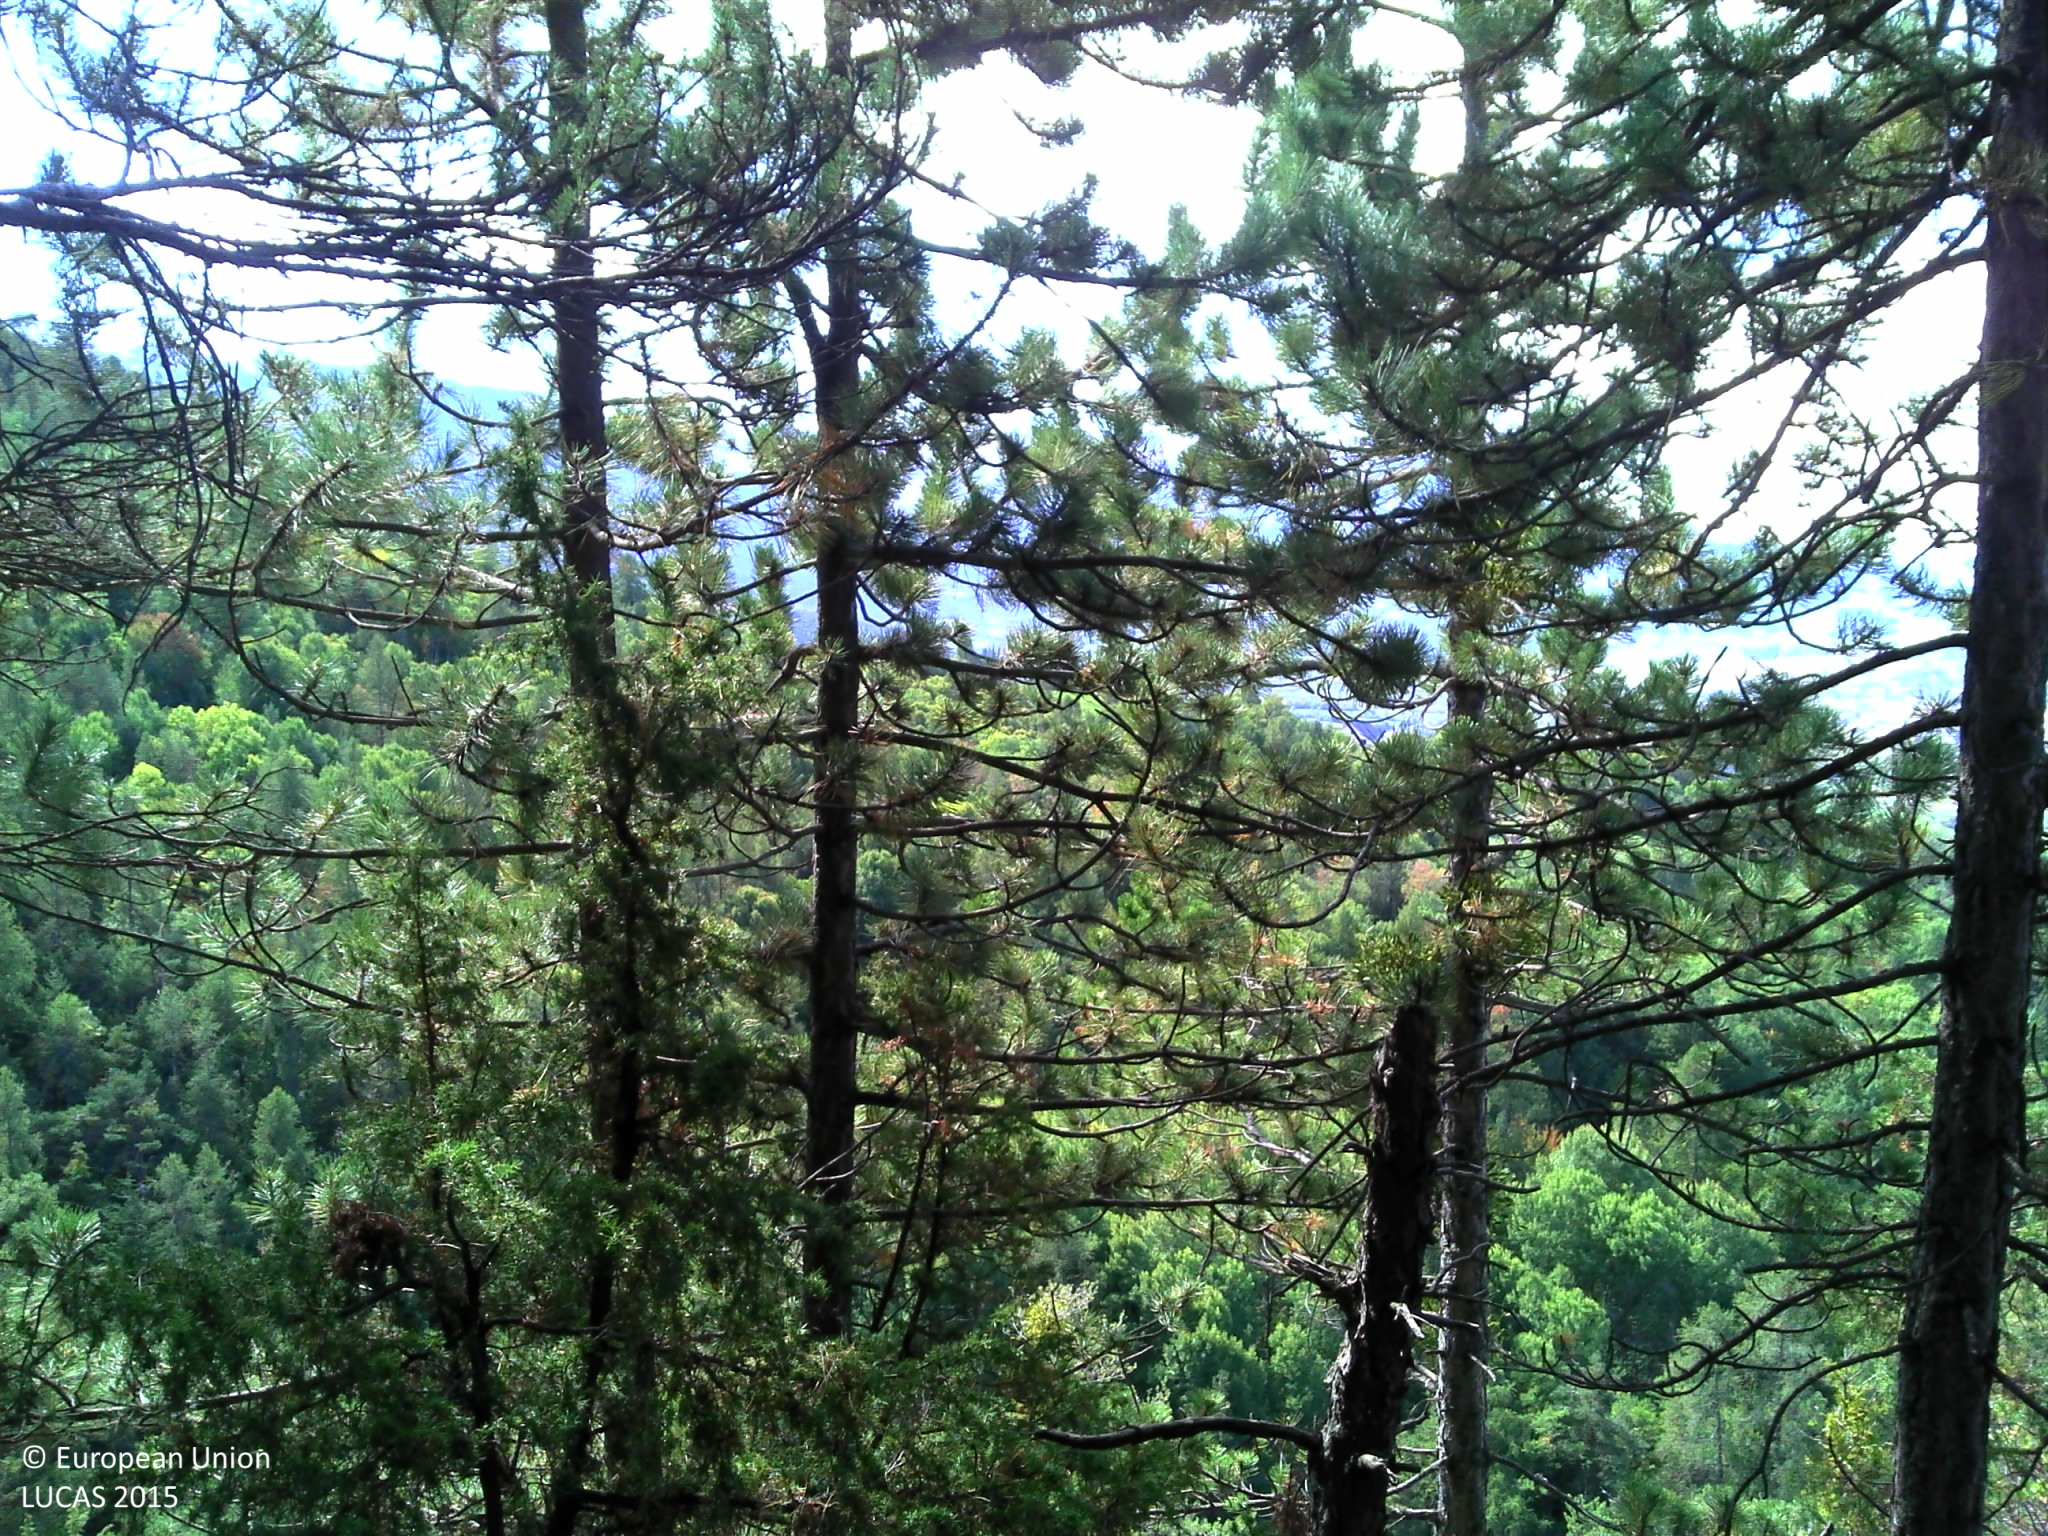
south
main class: Woodland
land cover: Pine dominated coniferous woodland
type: alpine coniferous forest
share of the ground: > 75 %
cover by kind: coniferous forest trees 70 %, shrubs 10 %, unconsolidated bare surface 10 %, broadleaved forest trees 5 %, herbaceous plants 5 %
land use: Semi-natural and natural areas not in use
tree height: > 5 m
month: September
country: FR
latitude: 44.5818
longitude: 6.5427
